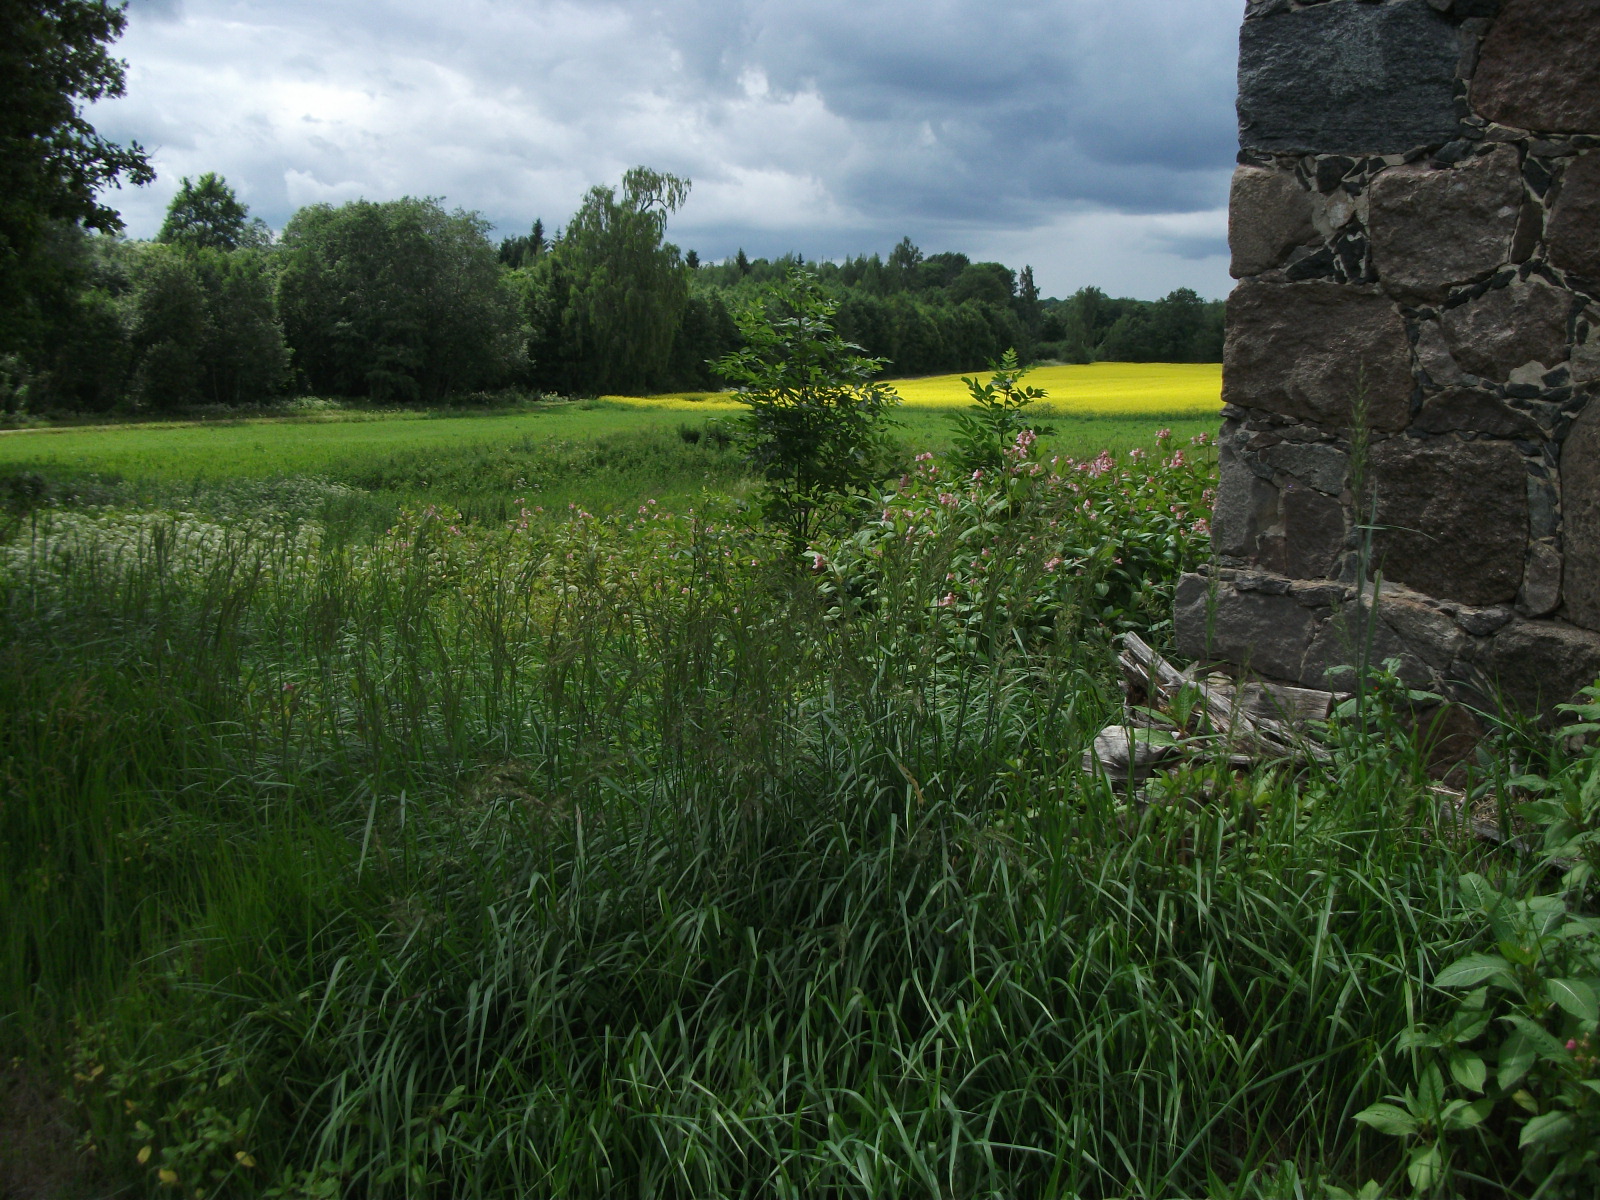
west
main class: Grassland
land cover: Grassland without tree/shrub cover
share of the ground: > 75 %
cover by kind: herbaceous plants 100 %
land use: Residential
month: July
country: LV
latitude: 57.0121
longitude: 26.2944
